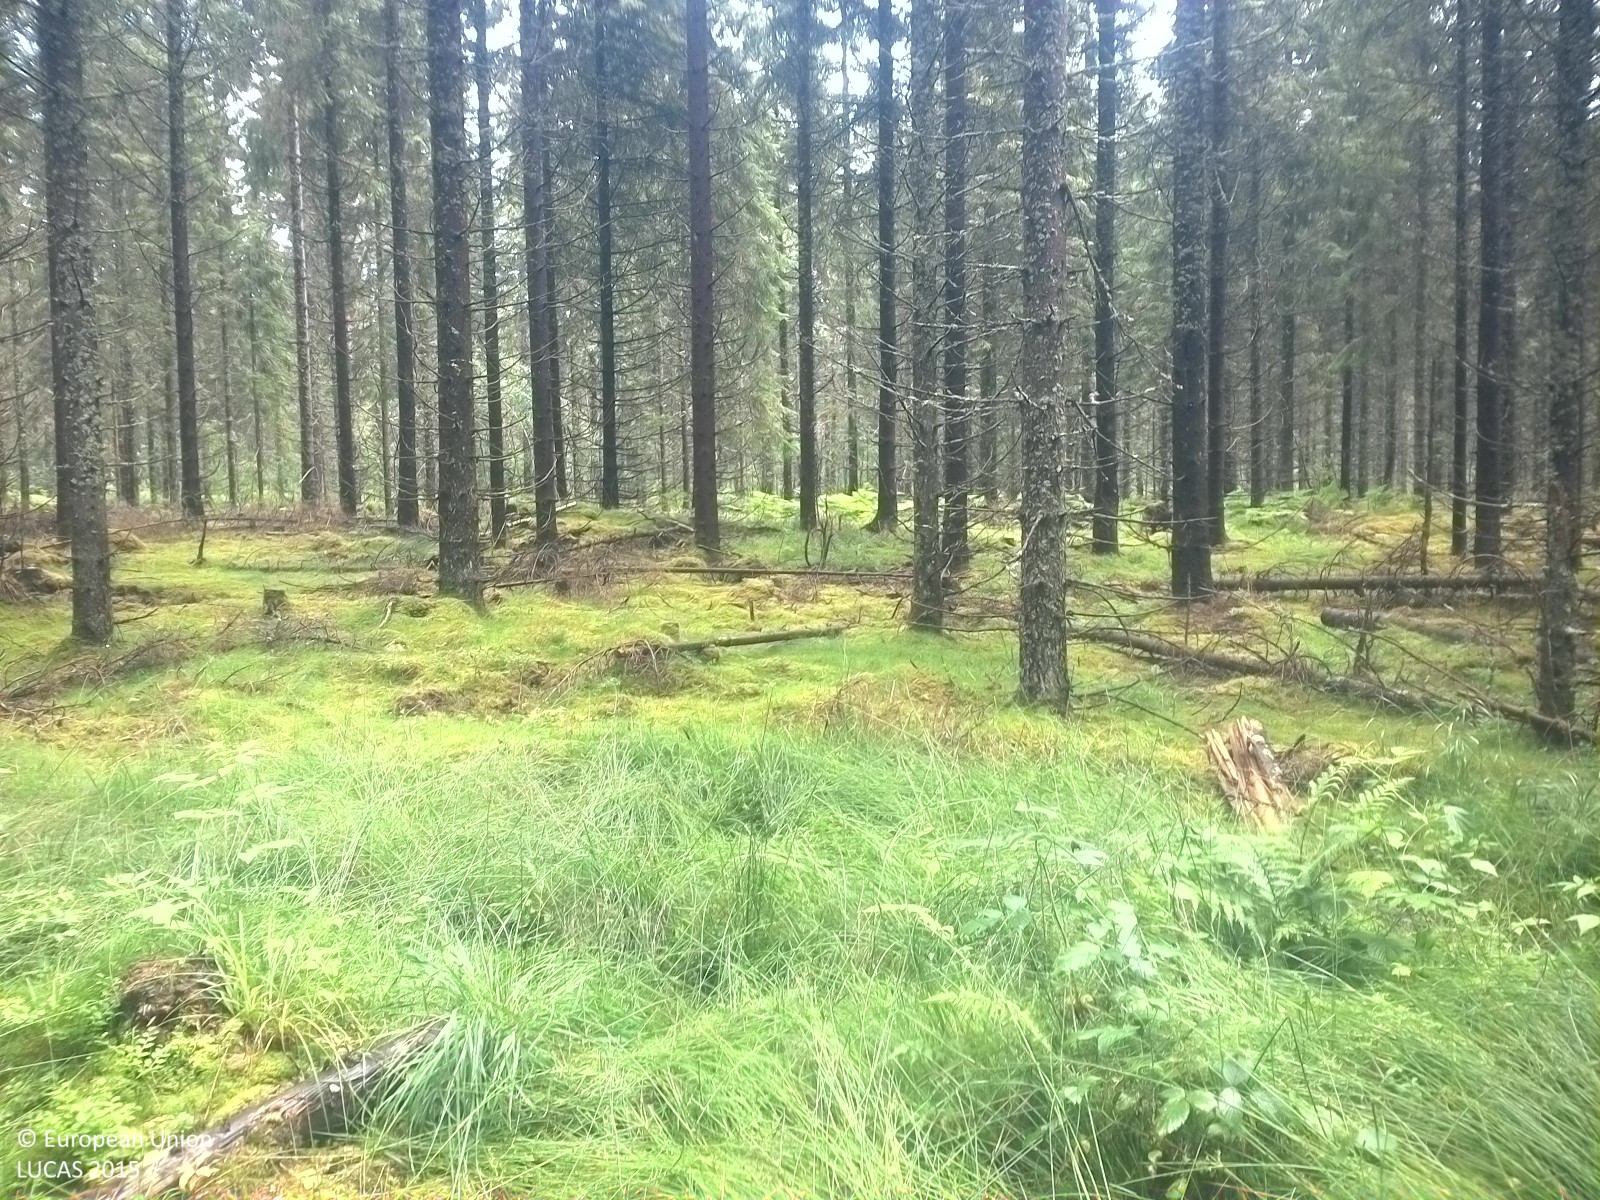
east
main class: Woodland
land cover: Spruce dominated coniferous woodland
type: boreal forest
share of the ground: 25 - 50 %
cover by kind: coniferous forest trees 40 %, lichens and mosses 35 %, herbaceous plants 25 %
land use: Forestry
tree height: > 5 m
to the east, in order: Spruce dominated coniferous woodland; Other coniferous woodland; Ditches and canals; Grass margins; Paved roads, cycling and walking lanes; Grass margins; Pine dominated mixed woodland; Pine dominated coniferous woodland; Pine dominated mixed woodland; Spruce dominated mixed woodland
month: July
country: SE
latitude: 58.8604
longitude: 15.1420
